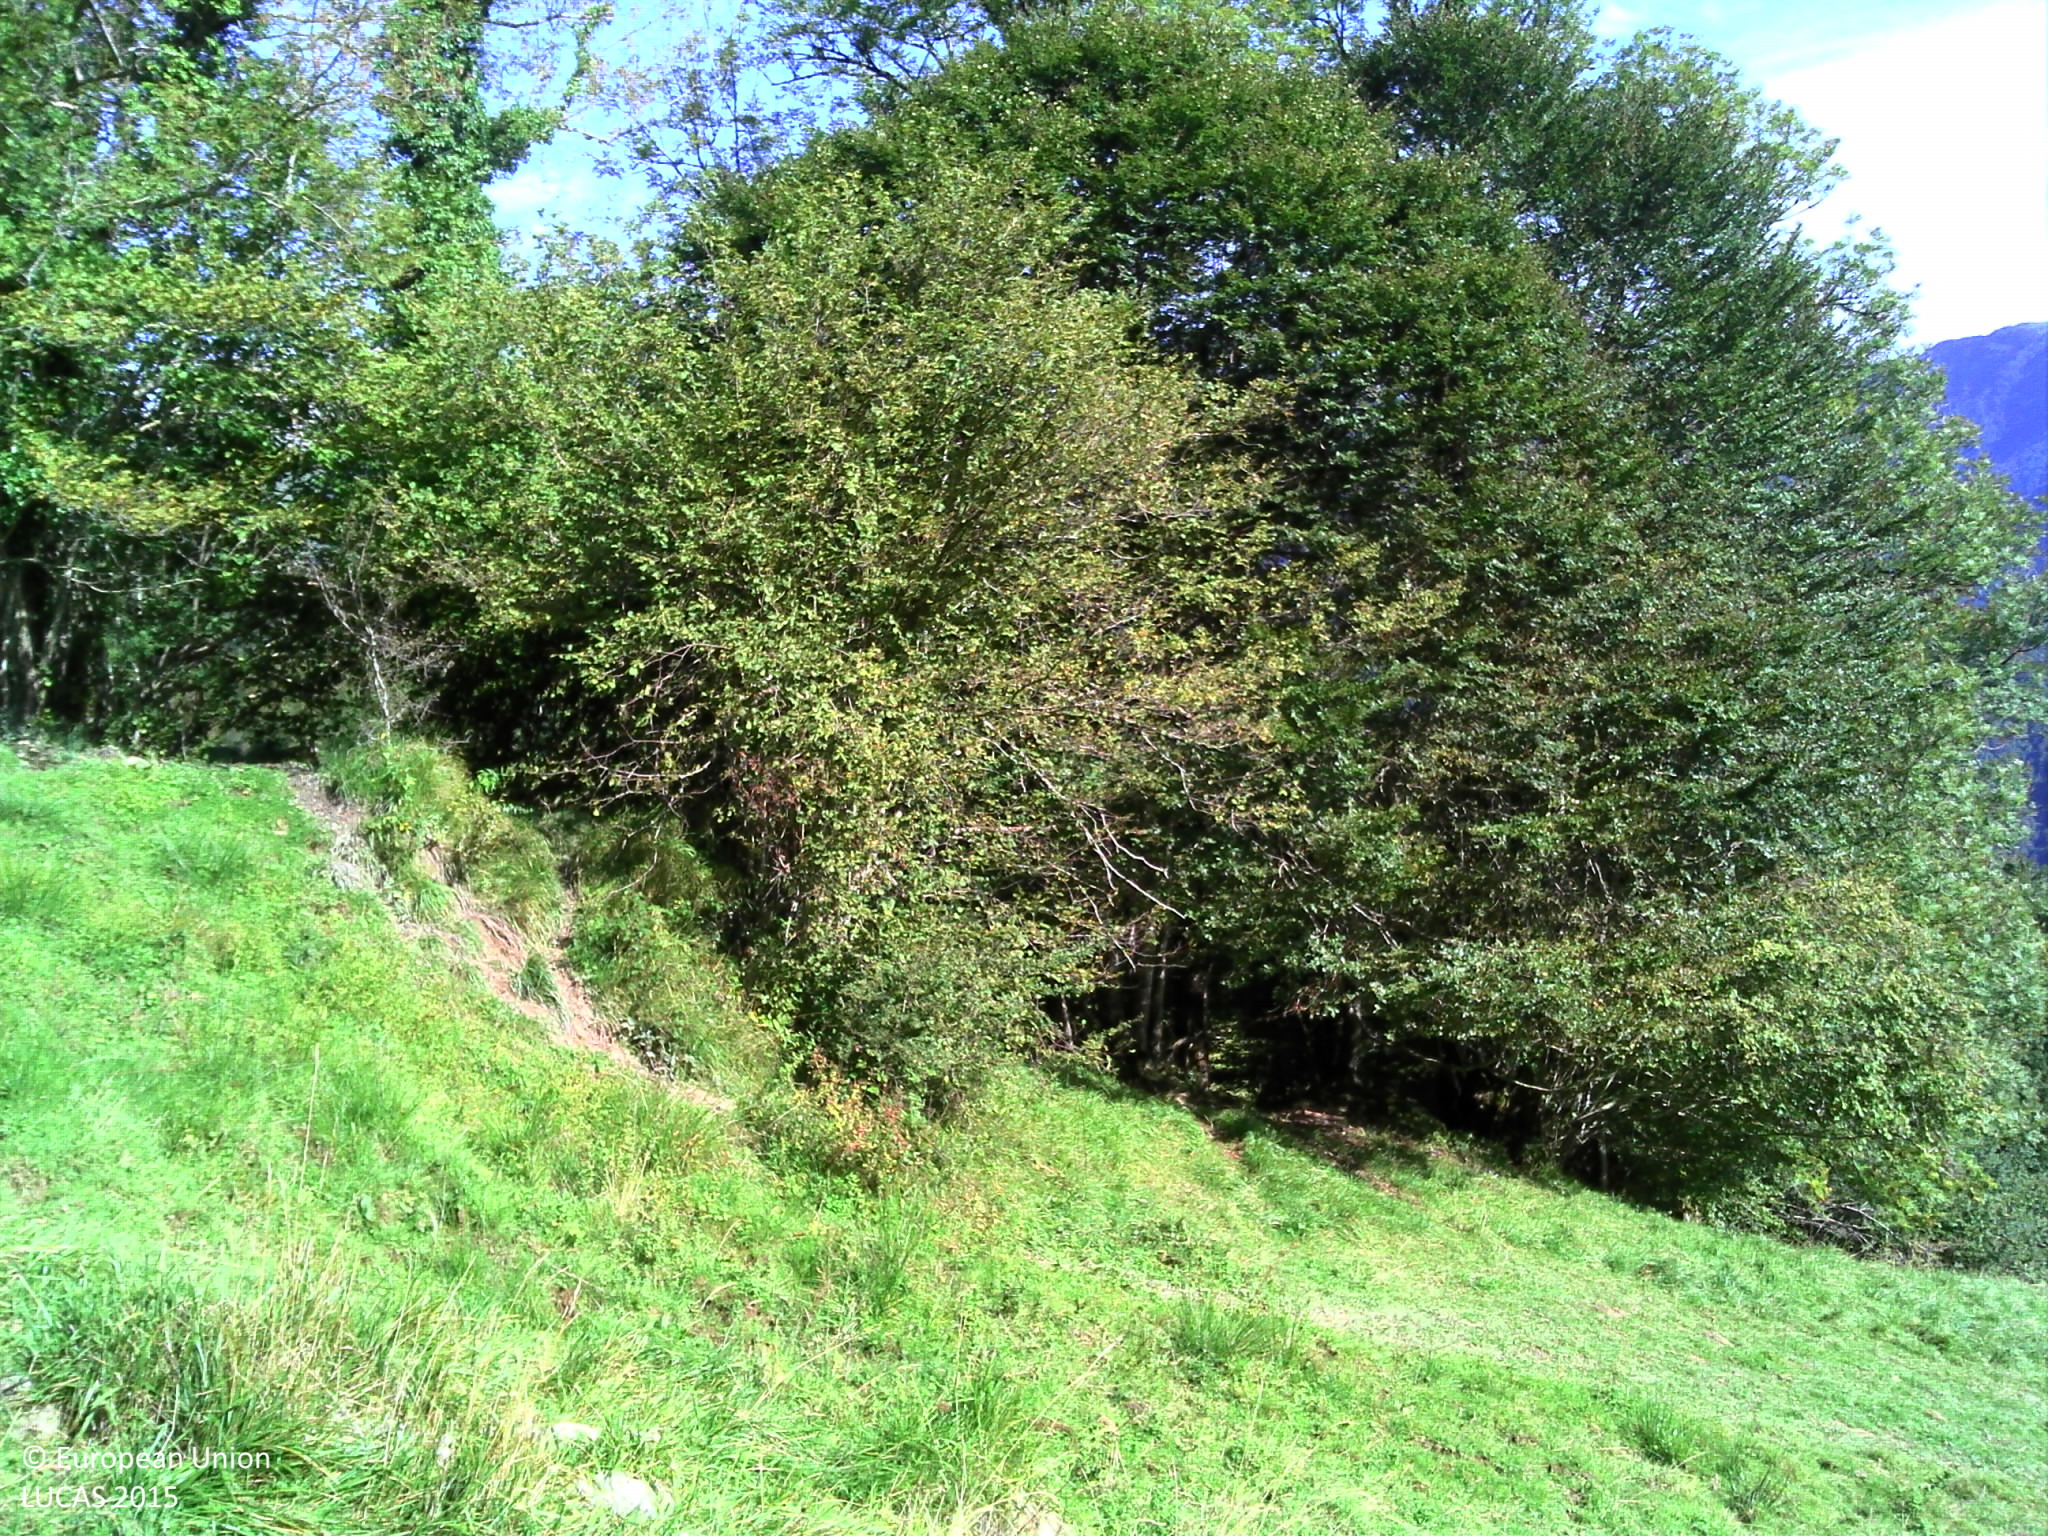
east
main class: Grassland
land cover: Grassland without tree/shrub cover
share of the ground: > 75 %
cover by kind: herbaceous plants 100 %
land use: Agriculture (excluding fallow land and kitchen gardens)
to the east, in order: Grassland without tree/shrub cover; Broadleaved woodland; Rivers and streams; Spontaneously vegetated surfaces; Grassland without tree/shrub cover; Broadleaved woodland; Tracks; Broadleaved woodland; Grassland without tree/shrub cover; Broadleaved woodland; Fences; Tracks; Grass margins; Broadleaved woodland; Shrubland without tree cover; Grassland without tree/shrub cover; Ditches and canals; Grass margins; Paved roads, cycling and walking lanes
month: September
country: FR
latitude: 43.0577
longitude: -0.6278
